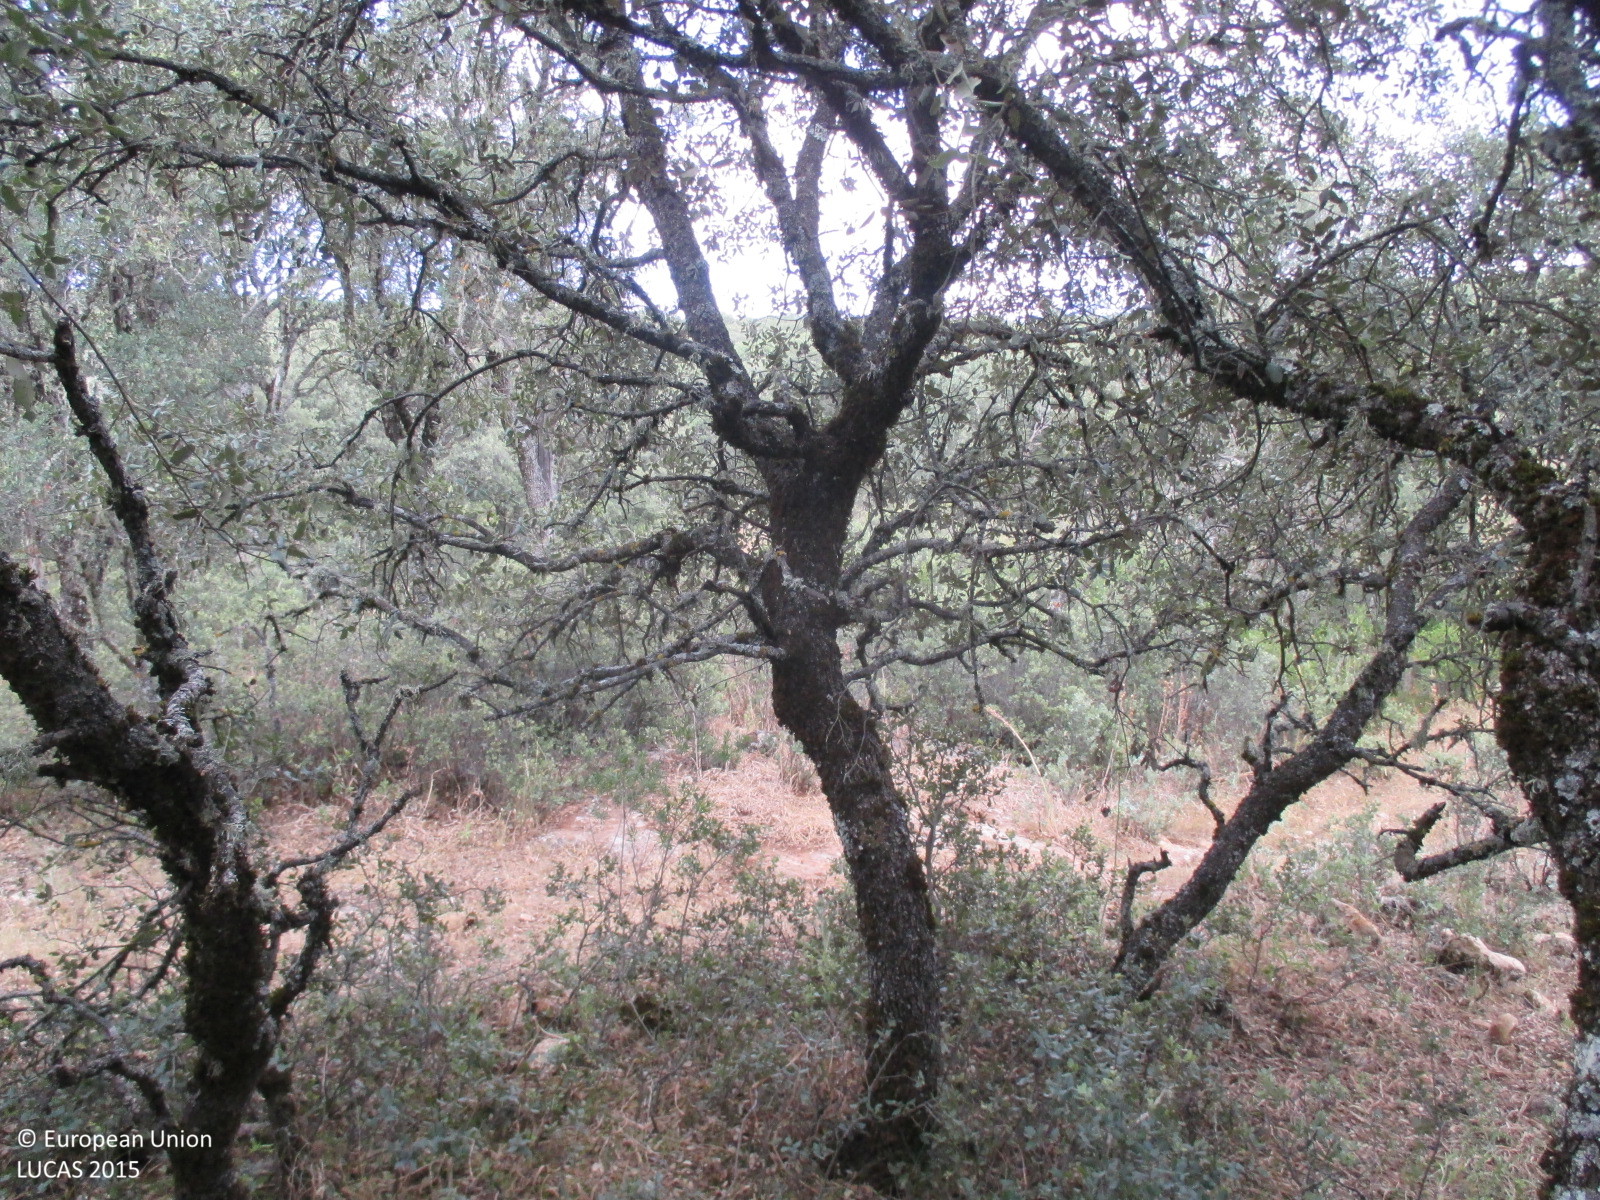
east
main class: Woodland
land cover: Broadleaved woodland
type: broadleaved evergreen forest
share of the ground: 50 - 75 %
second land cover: Shrubland without tree cover
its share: 25 - 50 %
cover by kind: broadleaved forest trees 60 %, shrubs 30 %, herbaceous plants 10 %
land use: Forestry
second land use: Agriculture (excluding fallow land and kitchen gardens)
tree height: < 5 m
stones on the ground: < 10 %
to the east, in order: Broadleaved woodland; Shrubland without tree cover; Shrubland with sparse tree cover; Tracks; Broadleaved woodland; Shrubland with sparse tree cover; Broadleaved woodland
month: June
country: ES
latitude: 37.4381
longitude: -3.7725
